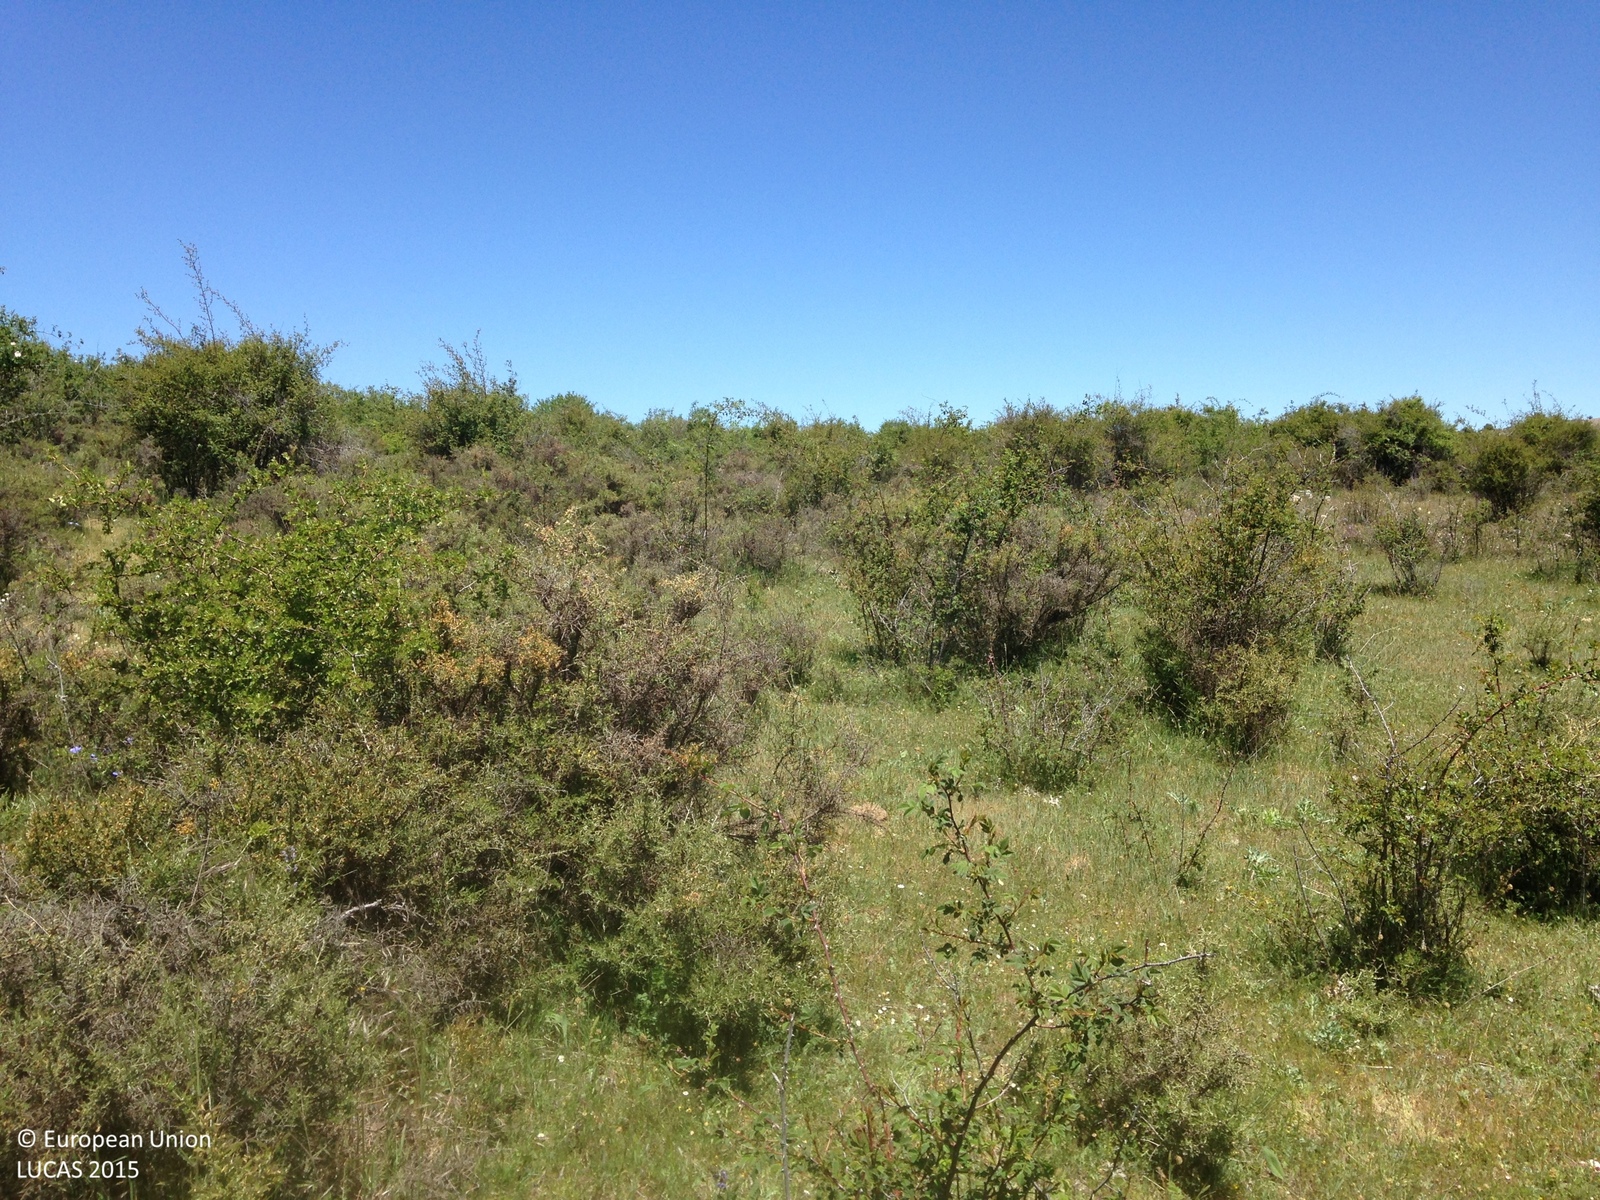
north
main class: Shrubland
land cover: Shrubland without tree cover
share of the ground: 50 - 75 %
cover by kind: shrubs 65 %, herbaceous plants 20 %, consolidated bare surface 15 %
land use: Semi-natural and natural areas not in use
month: May
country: ES
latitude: 40.5473
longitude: -2.0291
